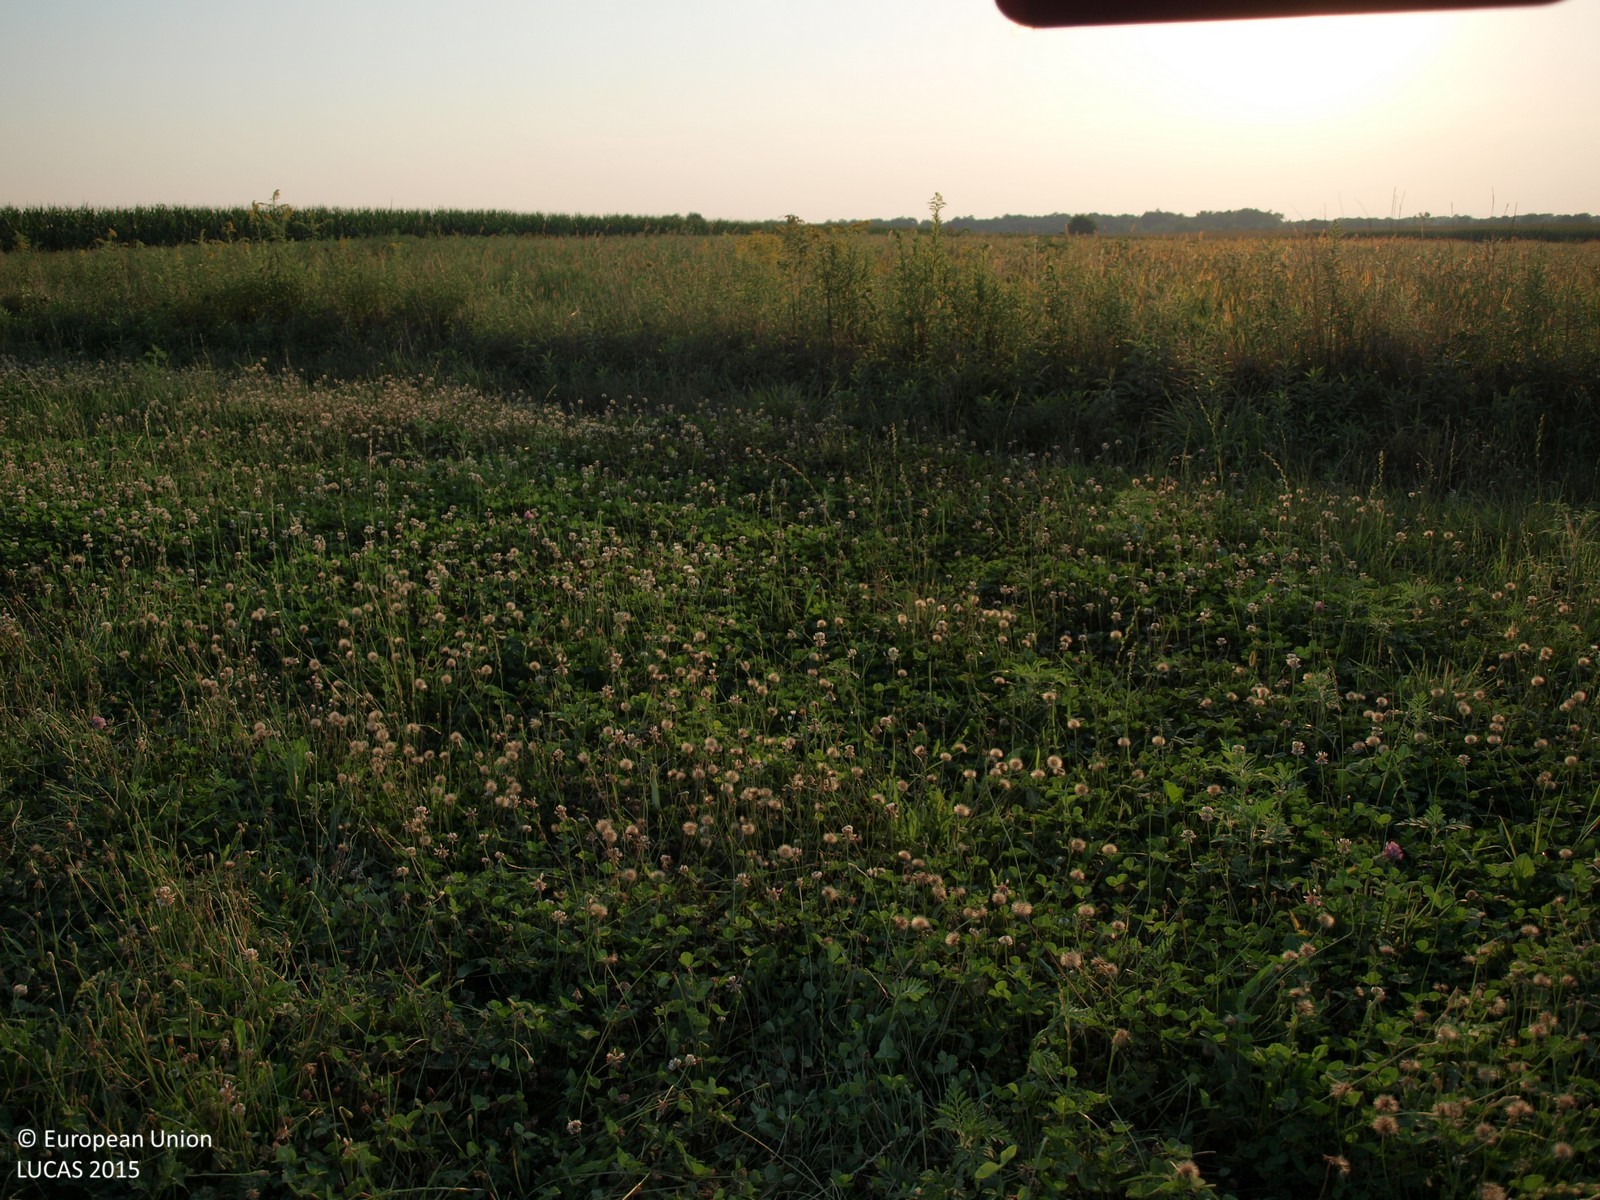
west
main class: Grassland
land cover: Grassland without tree/shrub cover
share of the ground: > 75 %
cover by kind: herbaceous plants 100 %
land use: Agriculture (excluding fallow land and kitchen gardens)
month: August
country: HR
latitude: 45.8282
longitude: 16.4999
